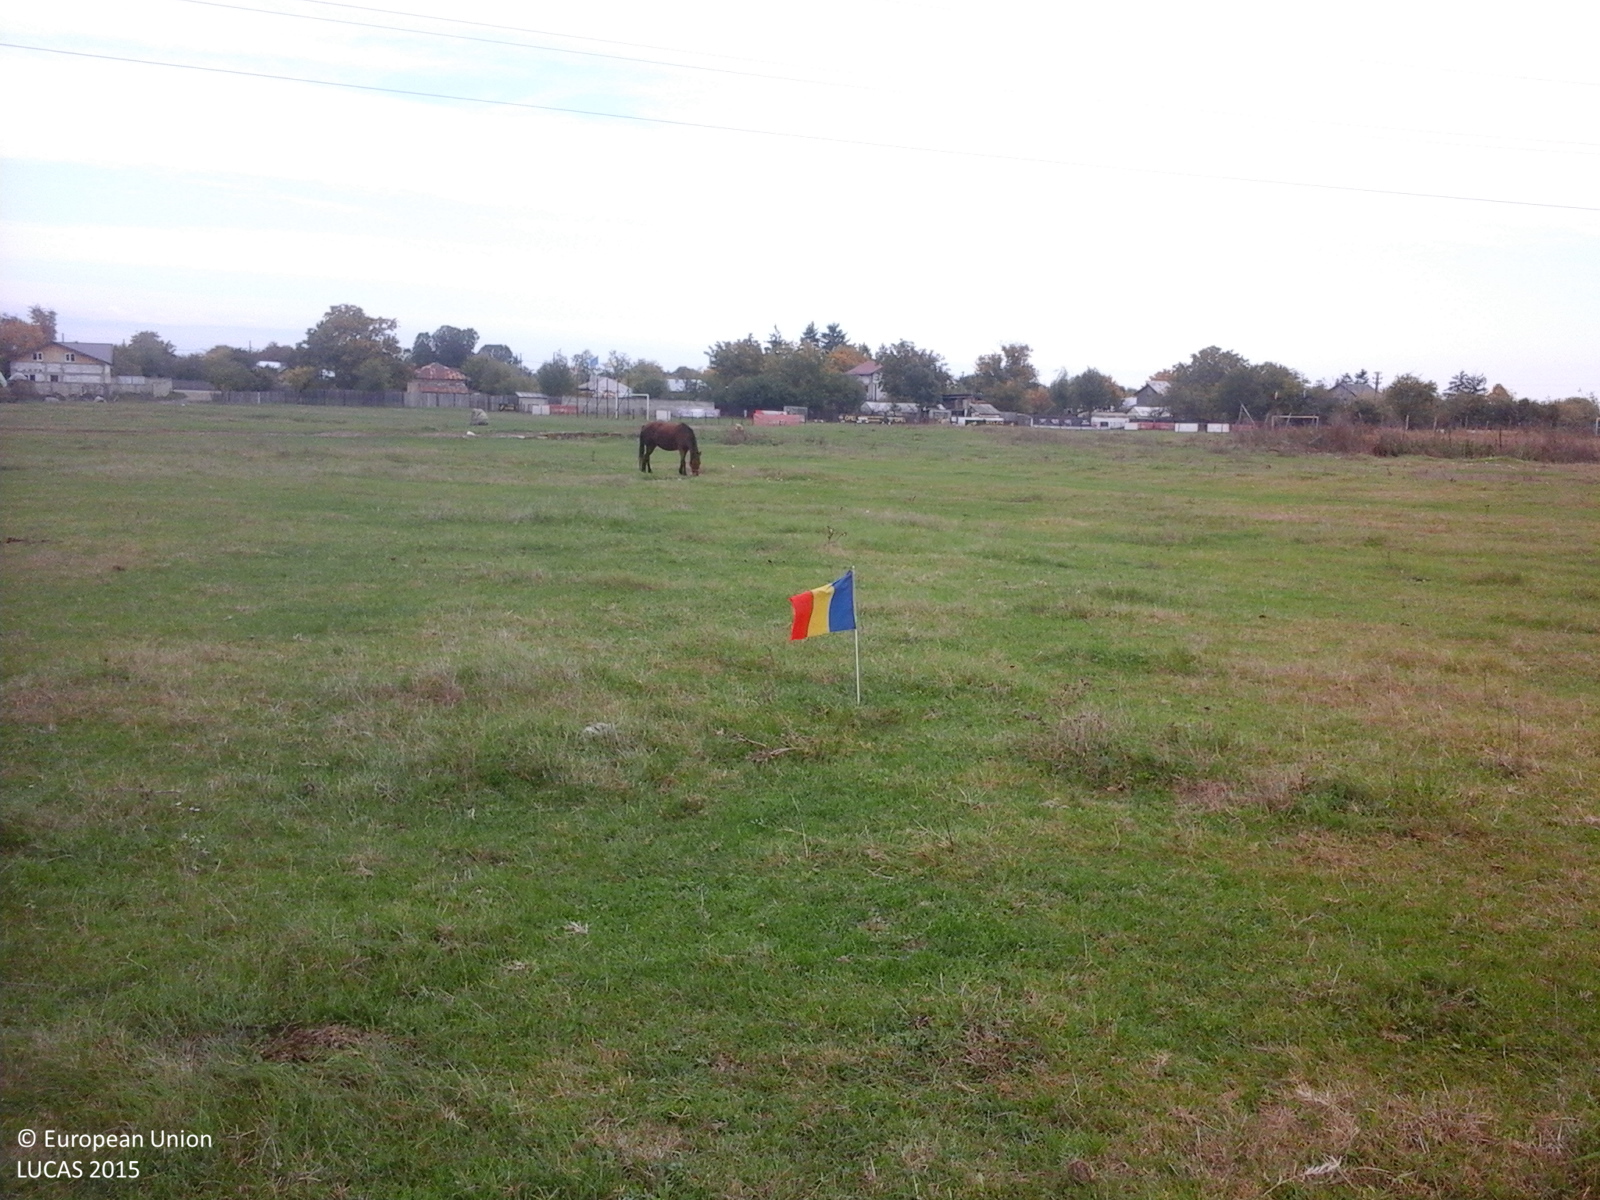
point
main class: Grassland
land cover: Grassland without tree/shrub cover
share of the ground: > 75 %
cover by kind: herbaceous plants 100 %
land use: Agriculture (excluding fallow land and kitchen gardens)
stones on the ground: < 10 %
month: October
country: RO
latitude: 44.8478
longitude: 26.0889
